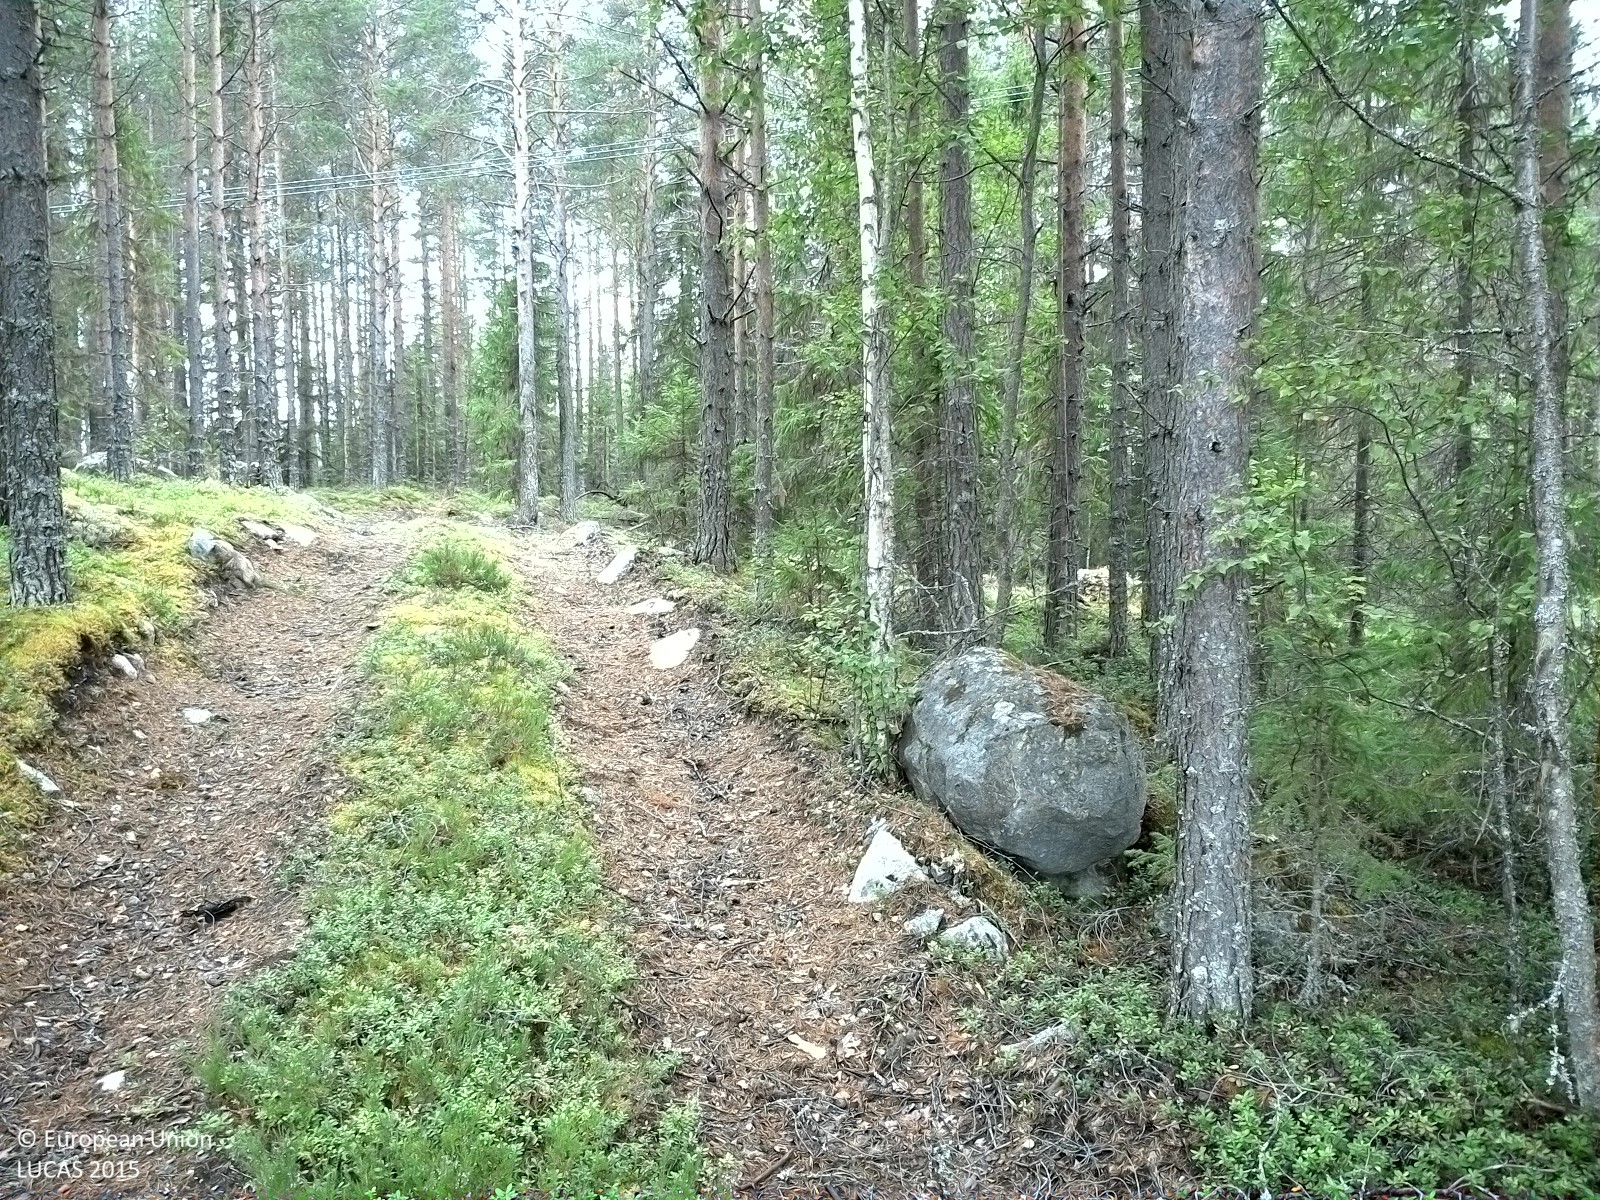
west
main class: Woodland
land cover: Pine dominated coniferous woodland
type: boreal forest
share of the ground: 50 - 75 %
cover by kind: coniferous forest trees 60 %, shrubs 20 %, lichens and mosses 20 %
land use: Forestry
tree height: > 5 m
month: August
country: SE
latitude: 62.6882
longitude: 16.5227
